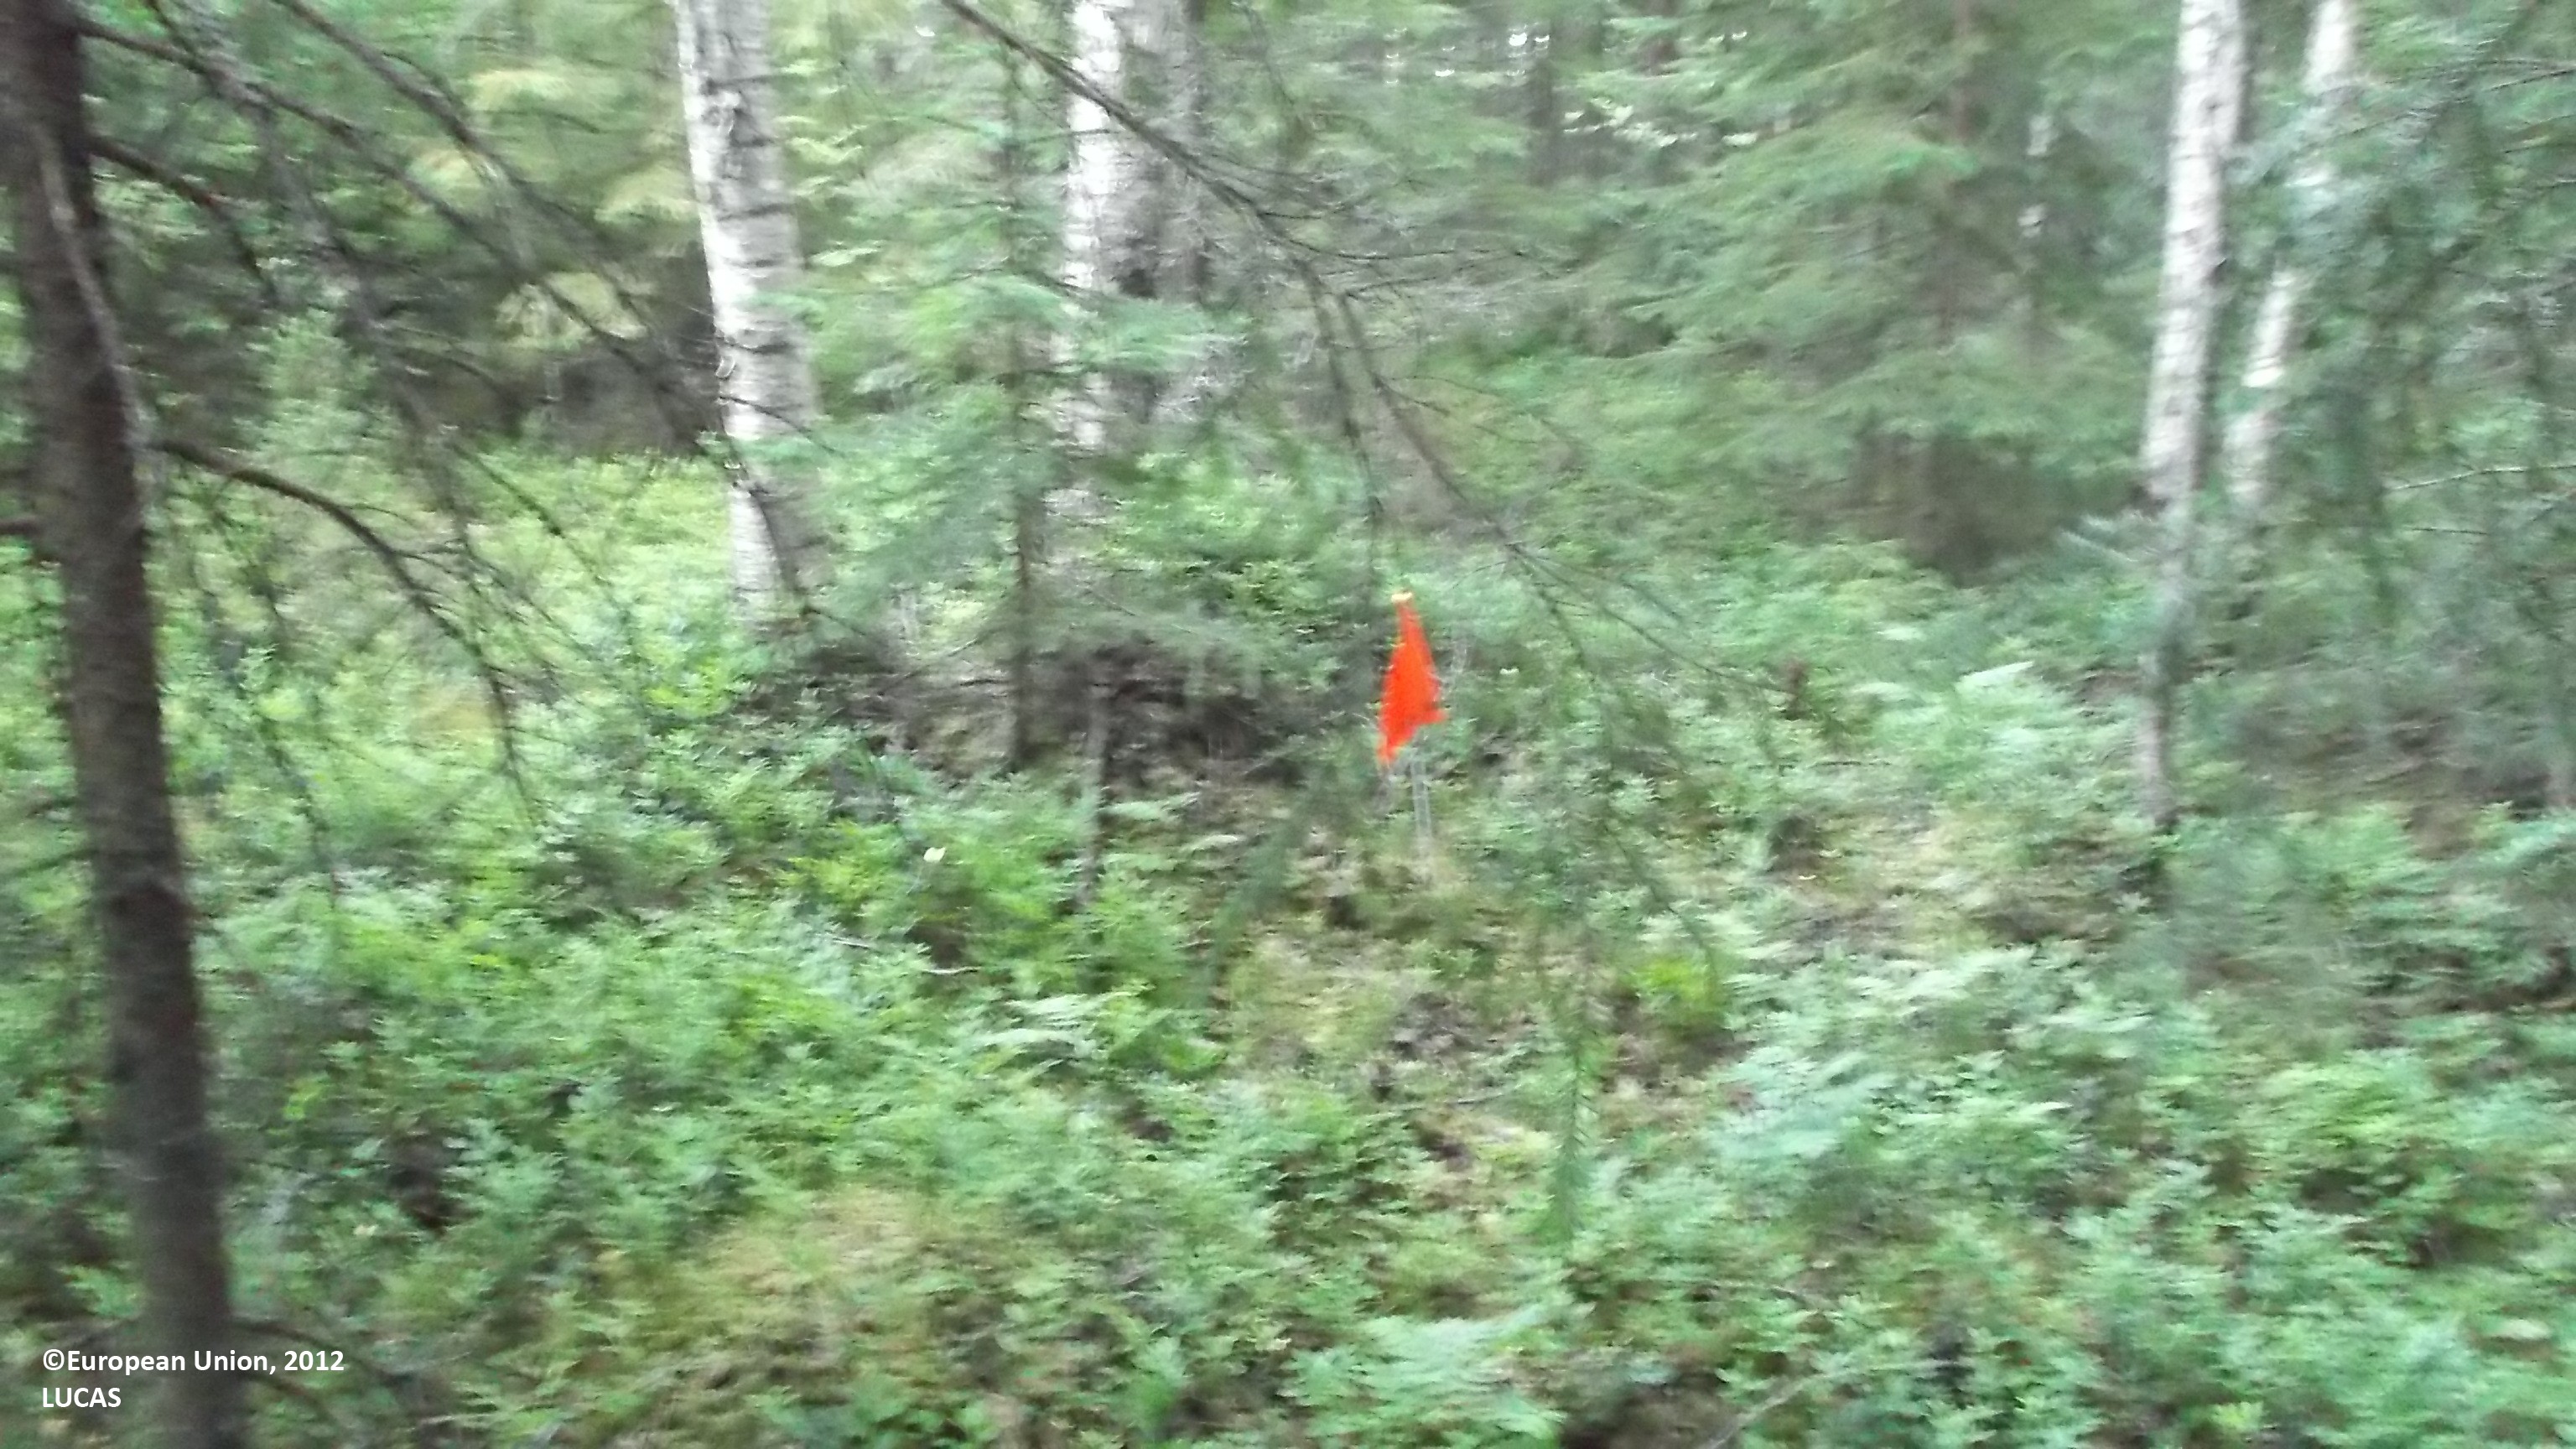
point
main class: Woodland
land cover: Spruce dominated mixed woodland
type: boreal forest
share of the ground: > 75 %
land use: Forestry
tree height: > 5 m
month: July
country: FI
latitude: 63.5938
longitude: 23.7497
